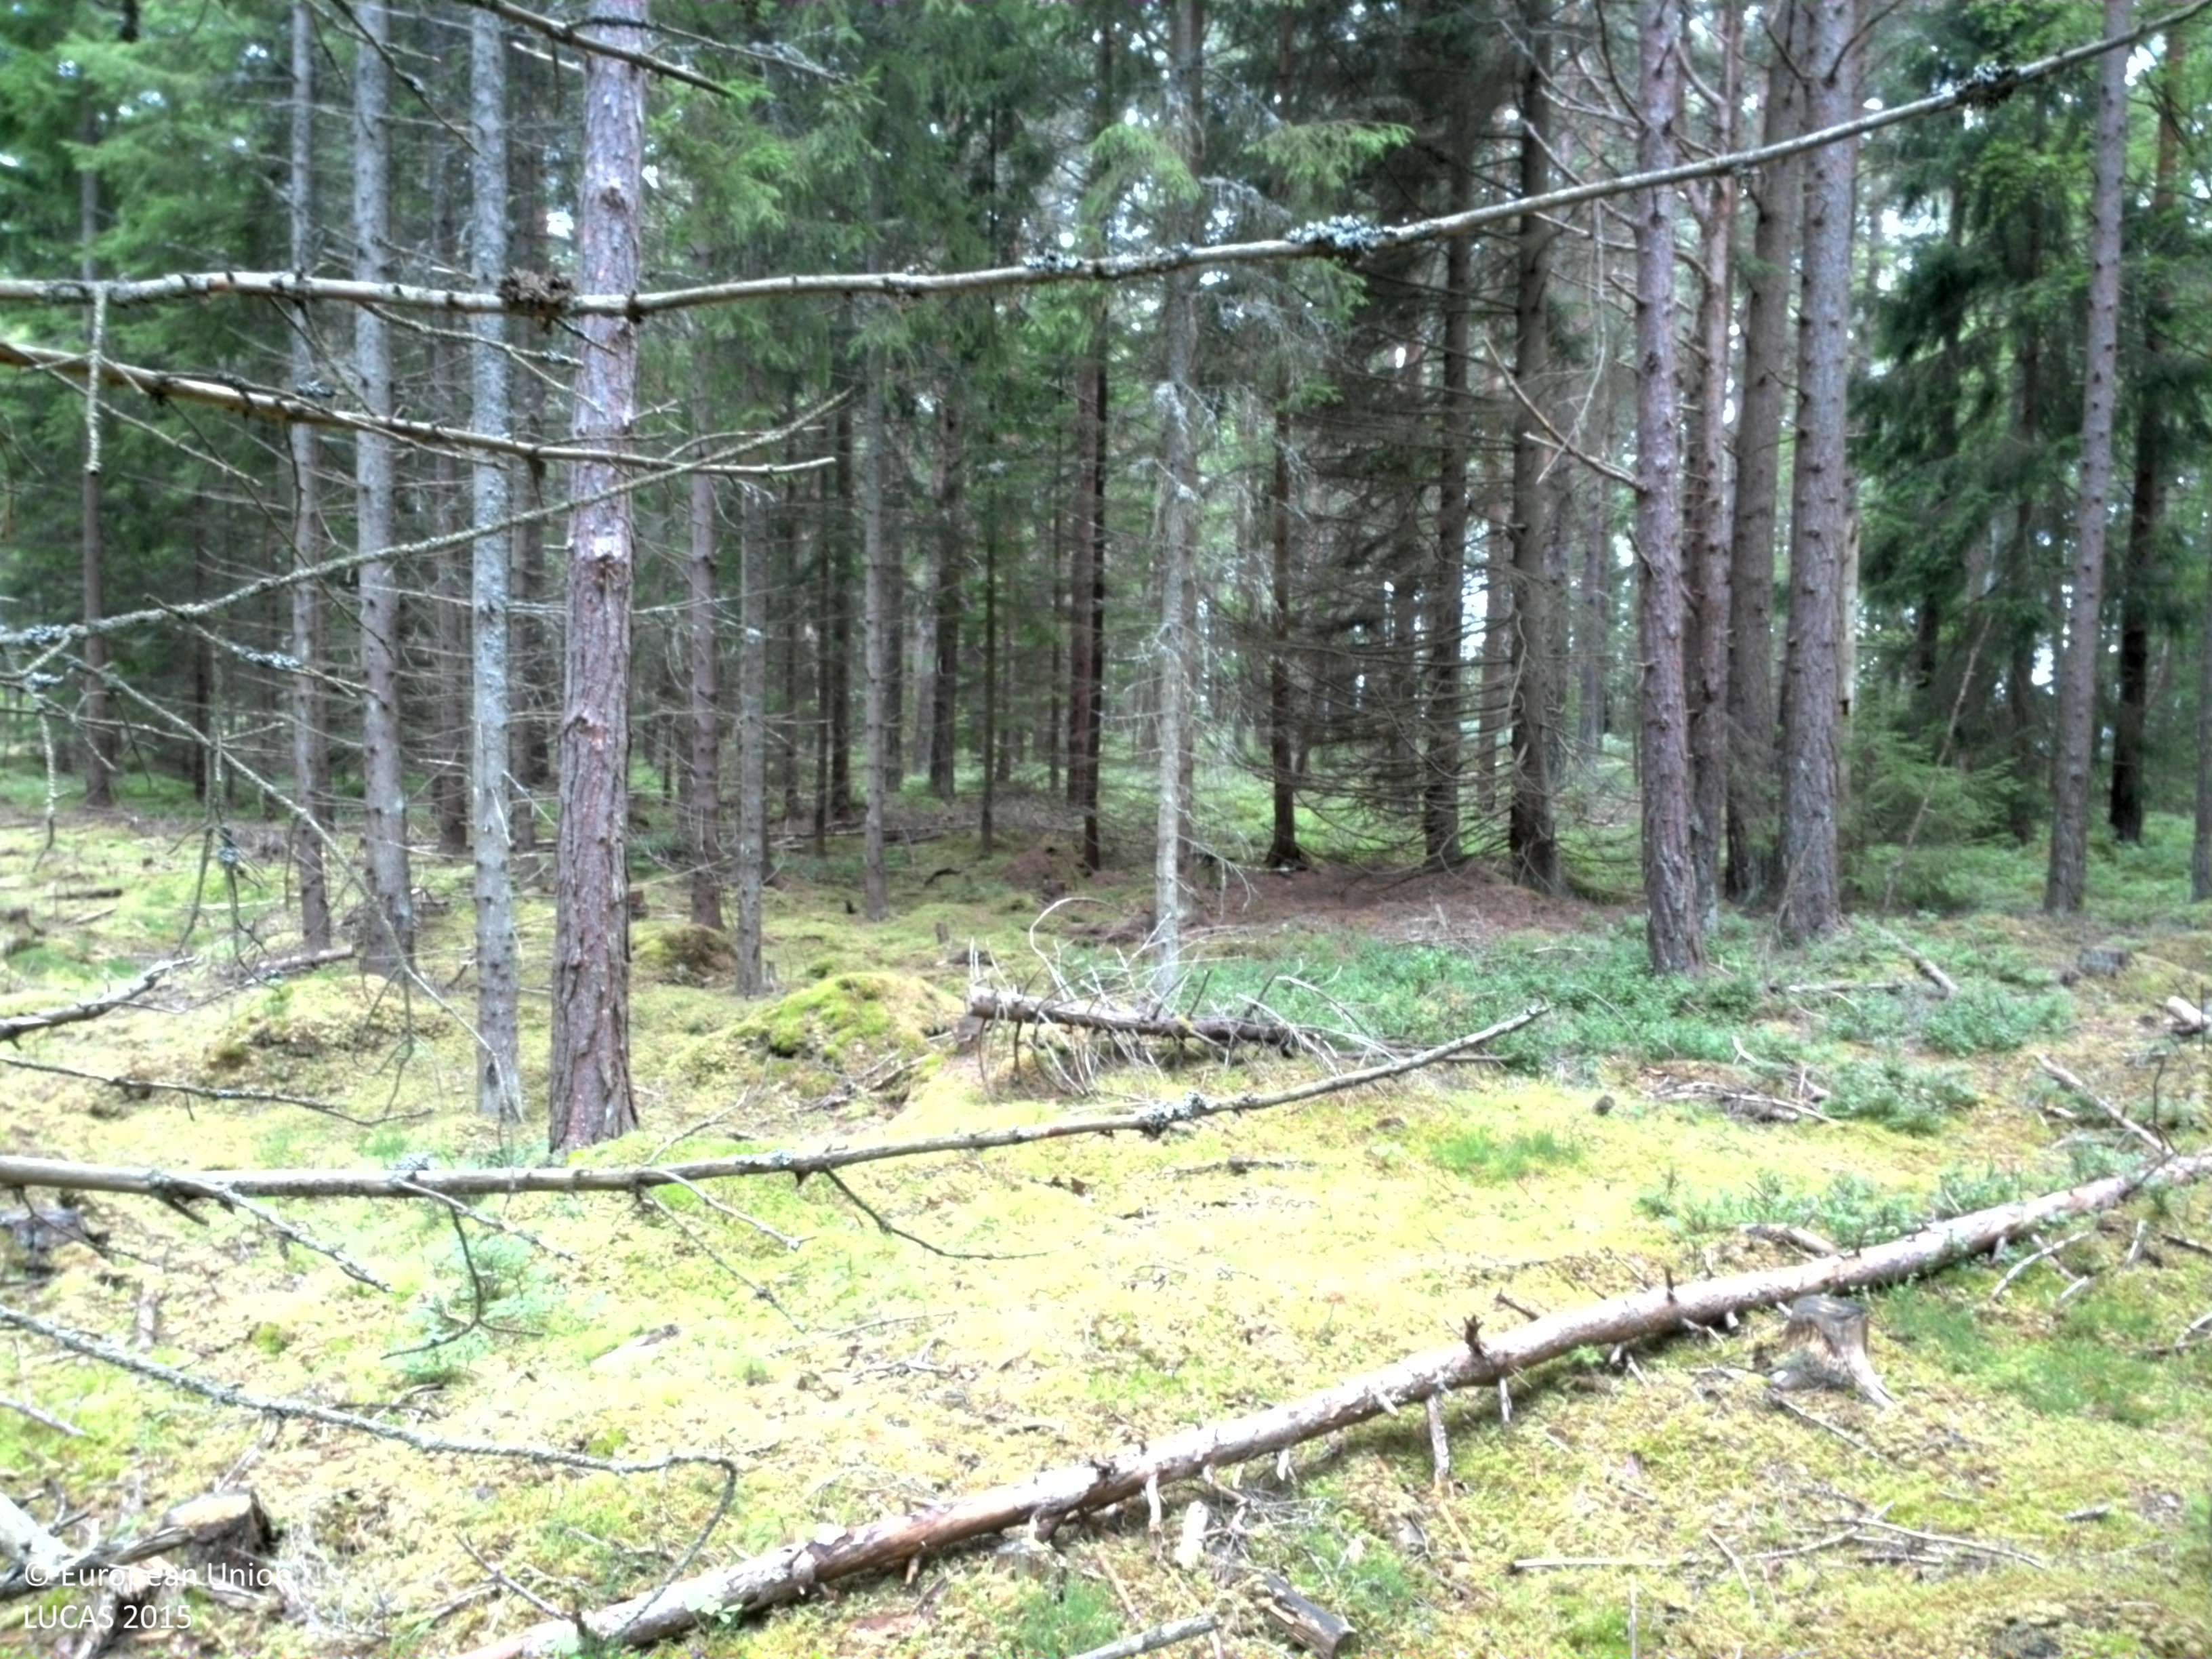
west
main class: Woodland
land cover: Spruce dominated coniferous woodland
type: boreal forest
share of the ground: 50 - 75 %
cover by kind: coniferous forest trees 75 %, lichens and mosses 25 %
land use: Forestry
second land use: Amenities, museums, leisure
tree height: > 5 m
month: July
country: SE
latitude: 58.6270
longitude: 13.3864
